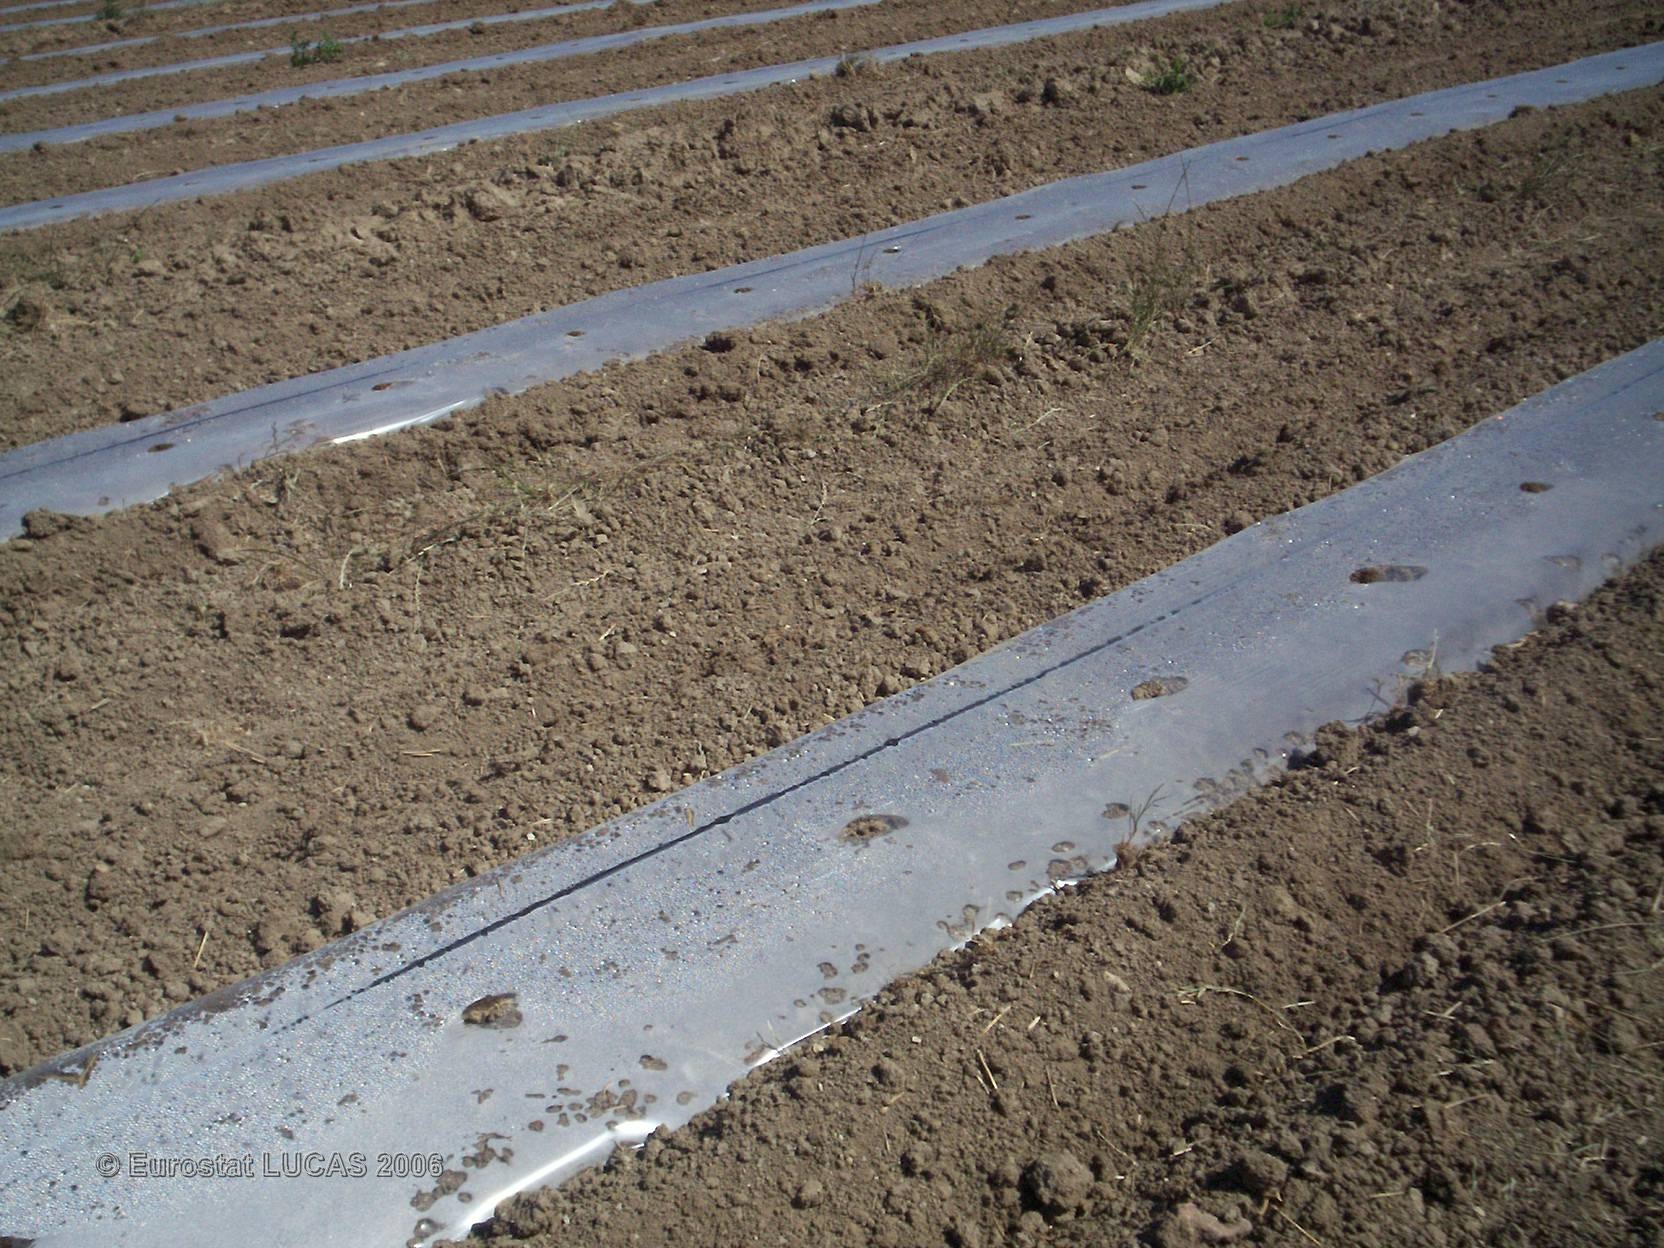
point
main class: Cropland
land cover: Other fresh vegetables
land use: Agriculture (excluding fallow land and kitchen gardens)
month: June
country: FR
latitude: 43.8992
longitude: 5.2653
